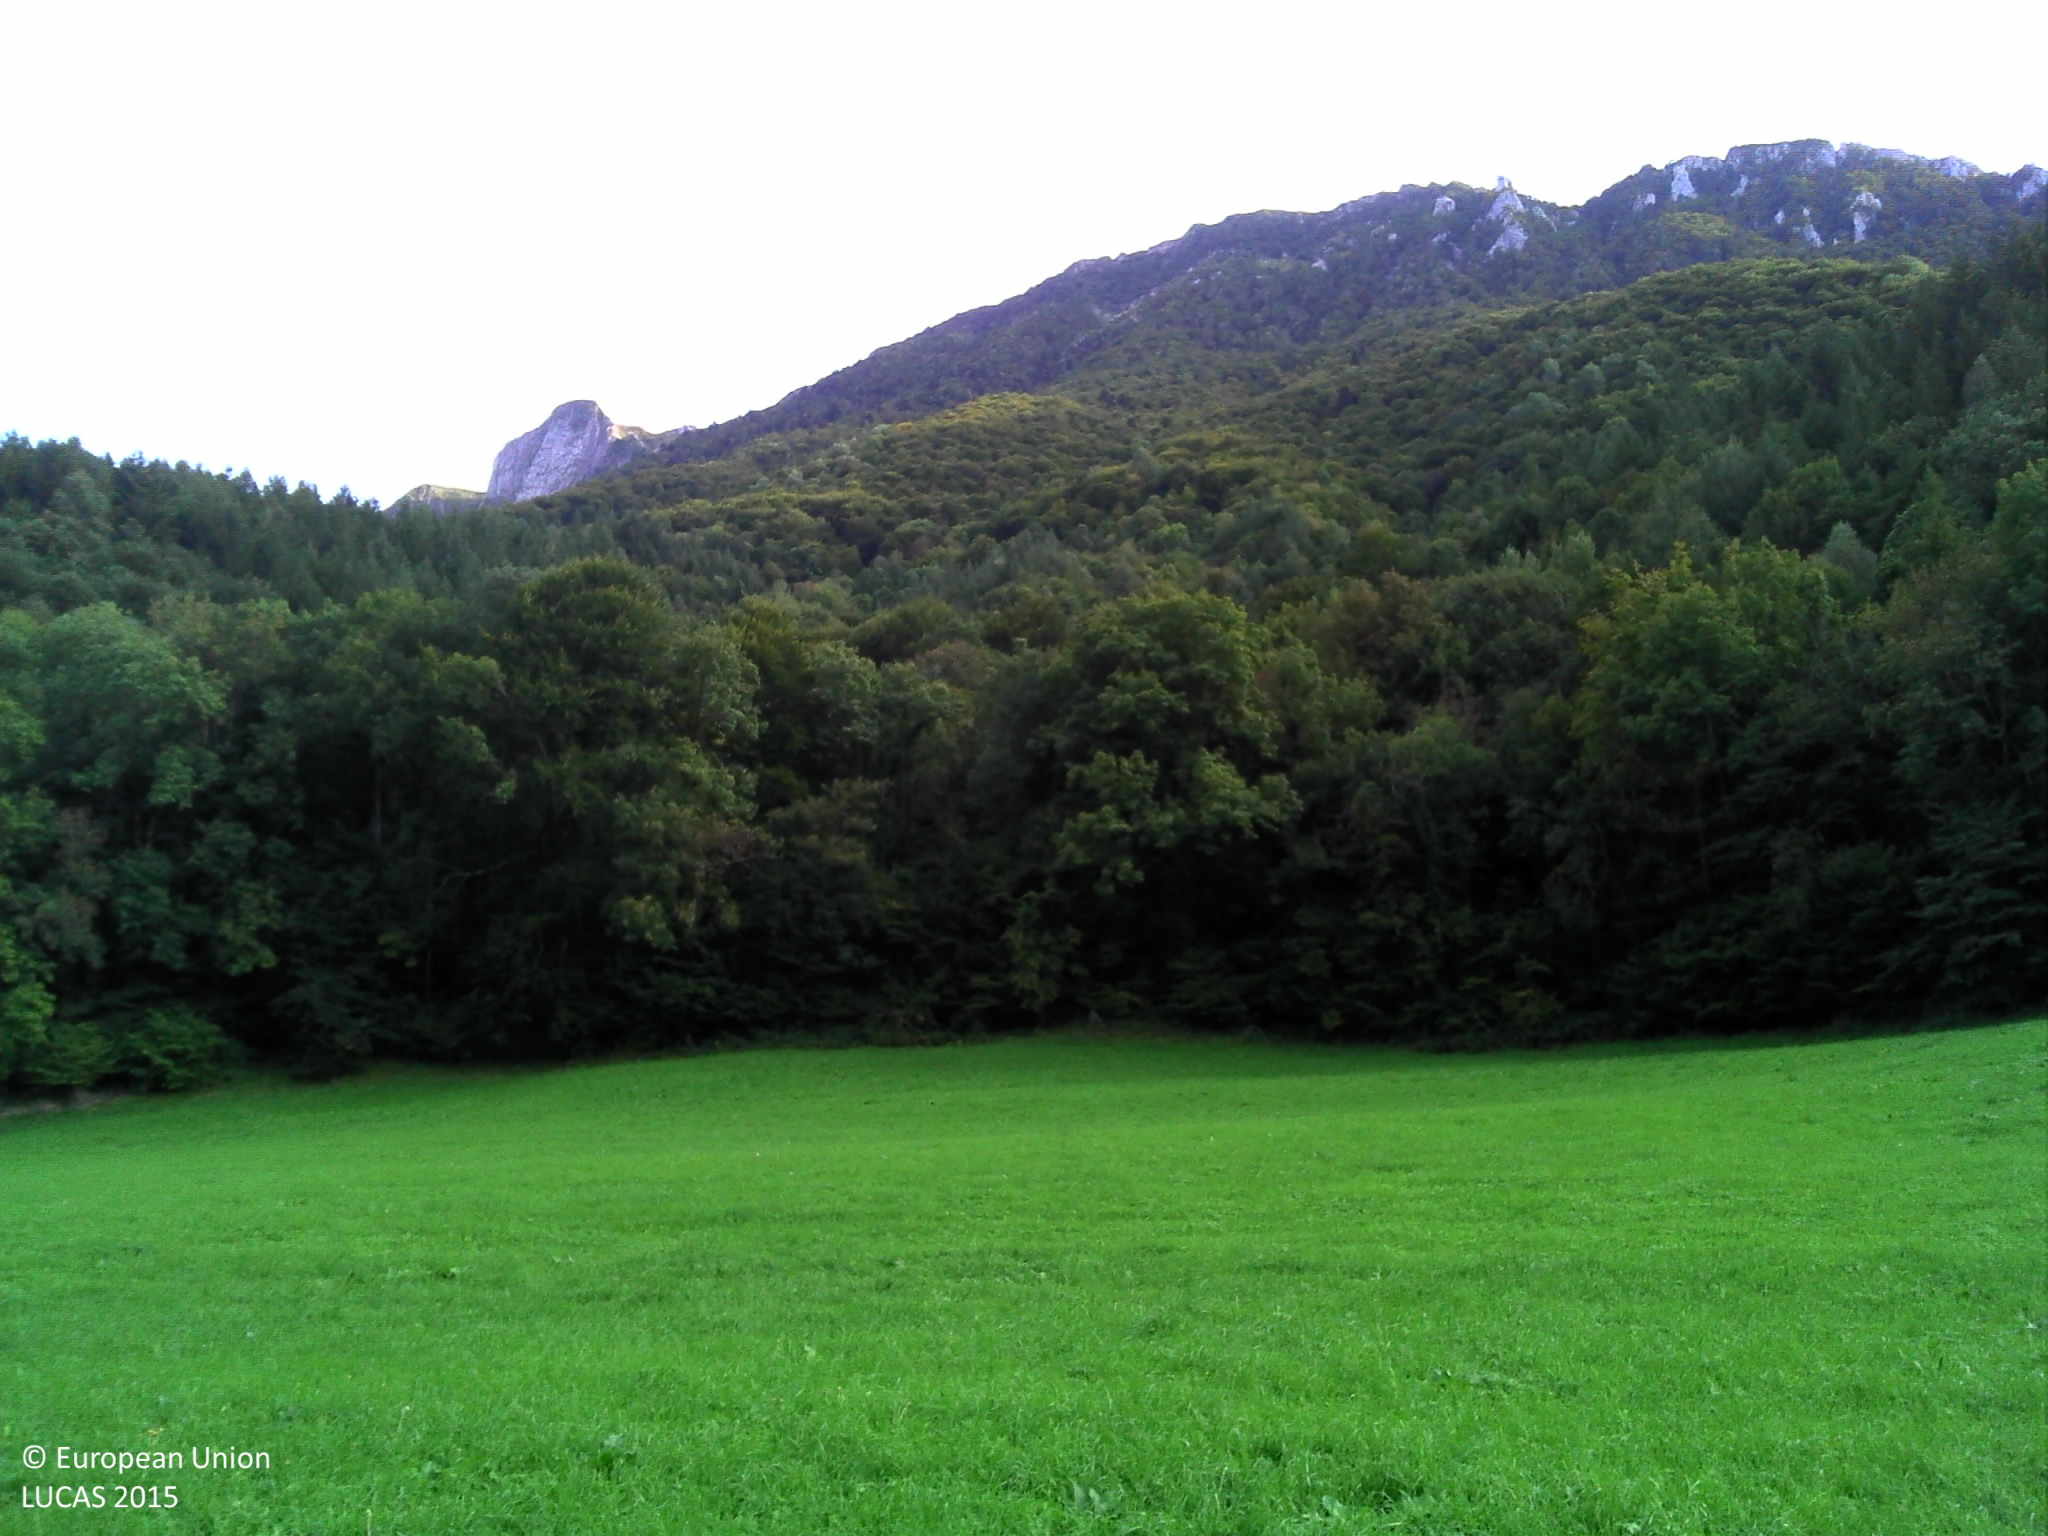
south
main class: Grassland
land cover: Grassland without tree/shrub cover
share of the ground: > 75 %
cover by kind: herbaceous plants 100 %
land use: Agriculture (excluding fallow land and kitchen gardens)
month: September
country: FR
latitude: 42.9709
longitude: -0.5873
